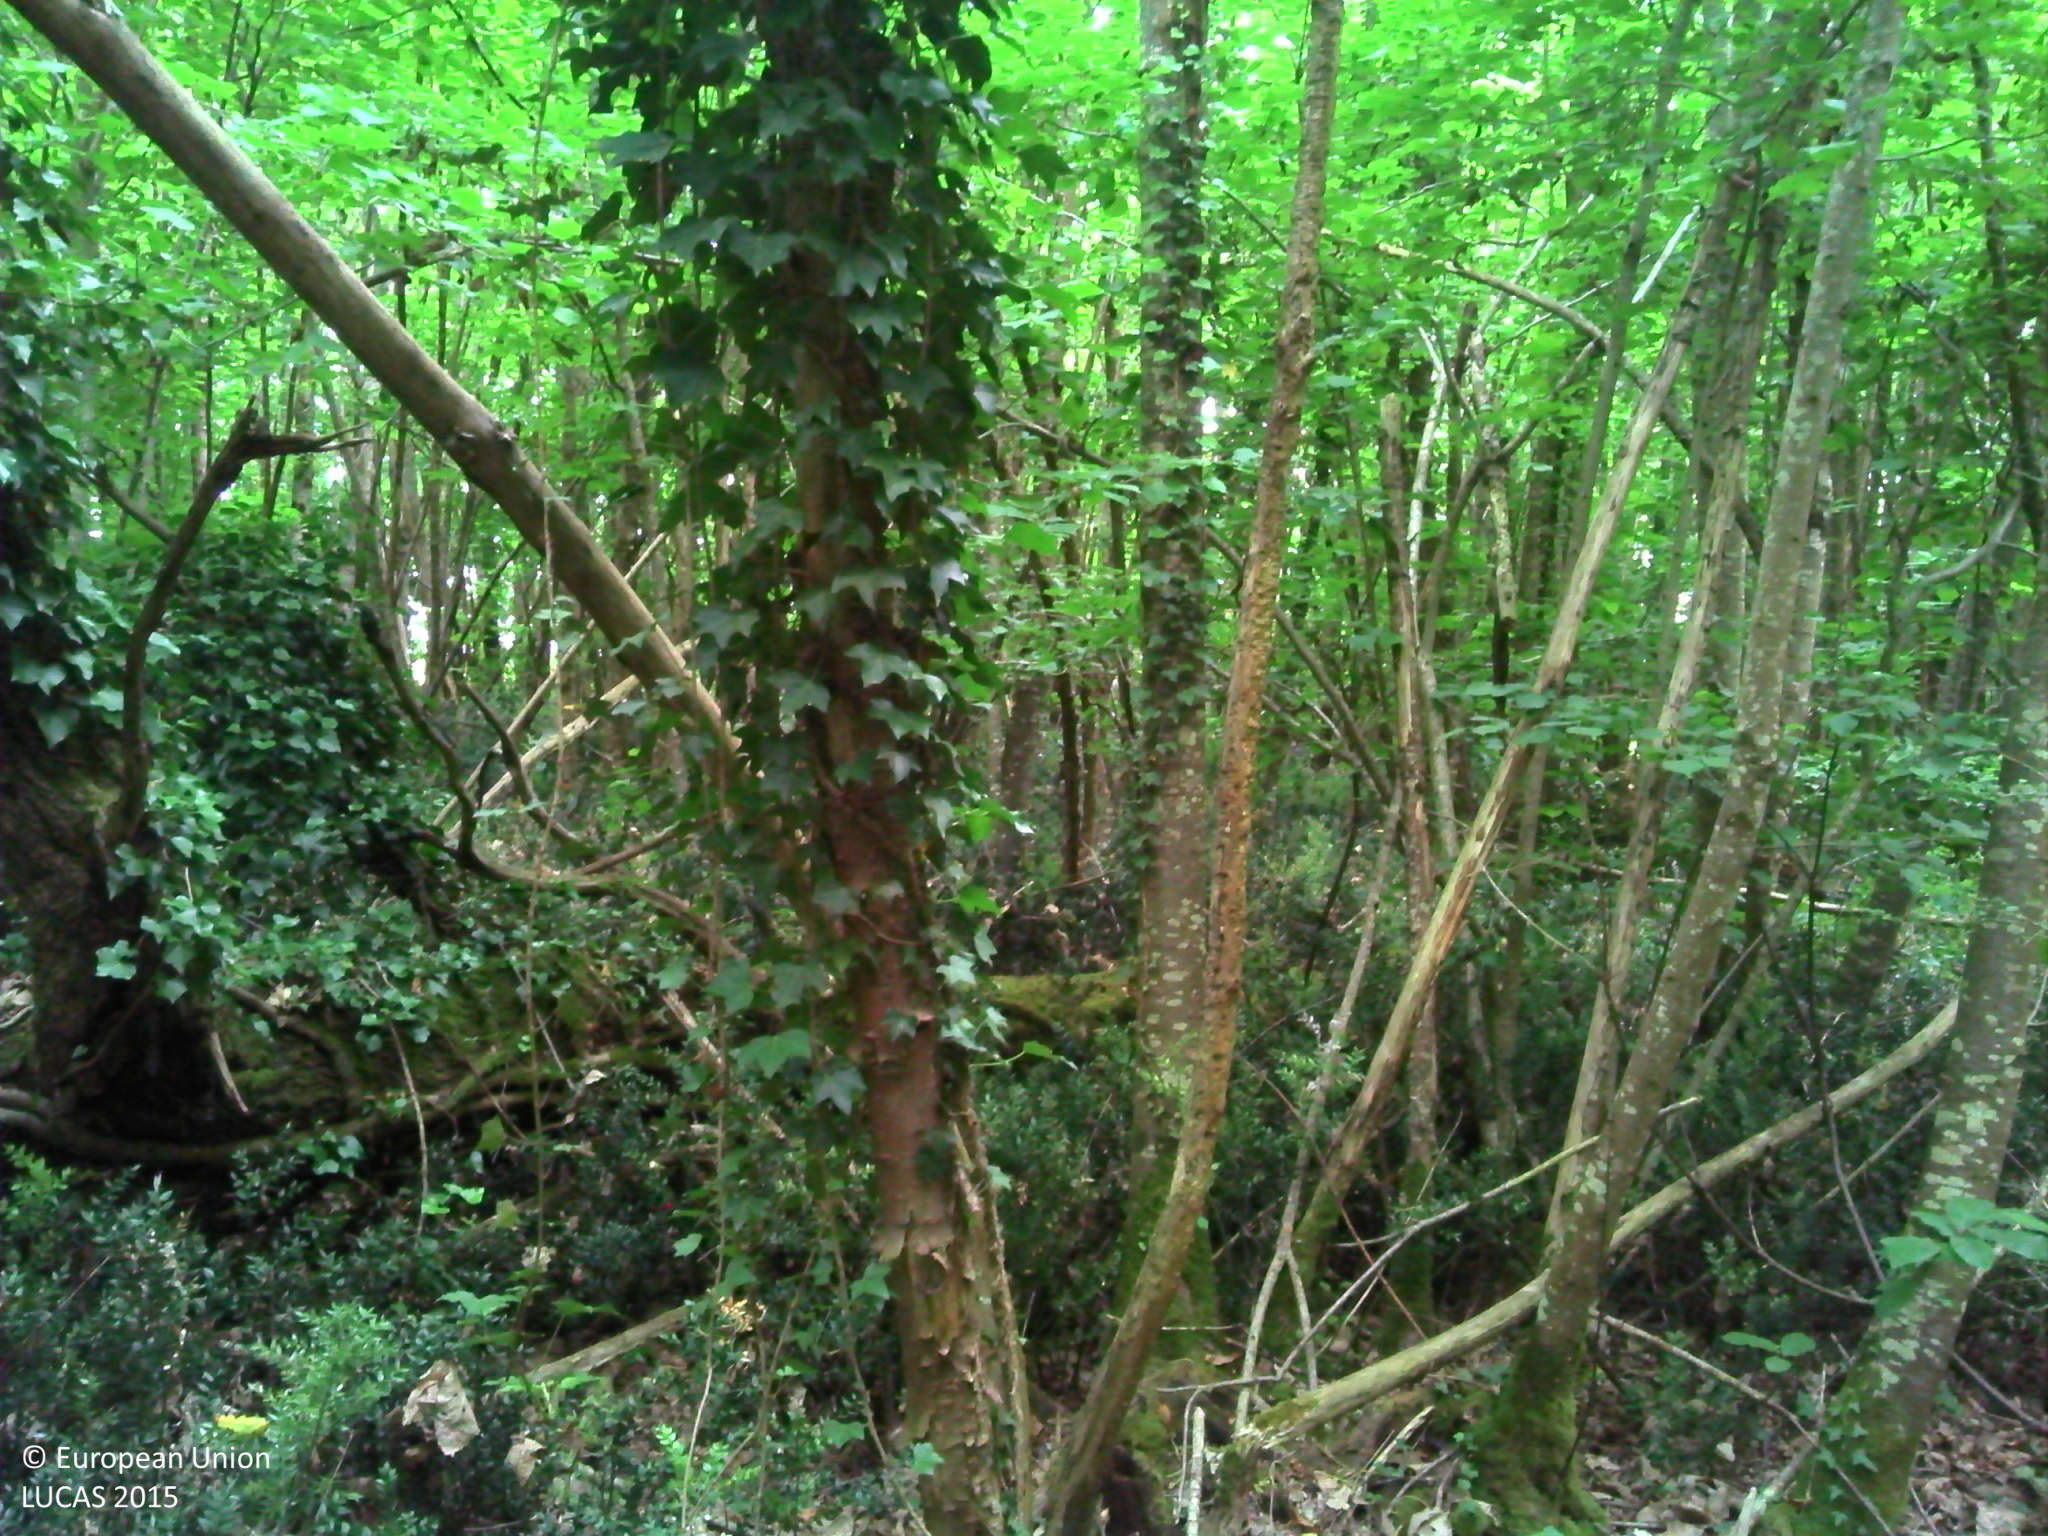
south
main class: Woodland
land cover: Broadleaved woodland
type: thermophilous deciduous forest
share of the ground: > 75 %
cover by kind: broadleaved forest trees 100 %
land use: Forestry
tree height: > 5 m
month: June
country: FR
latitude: 45.9453
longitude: 0.2956
